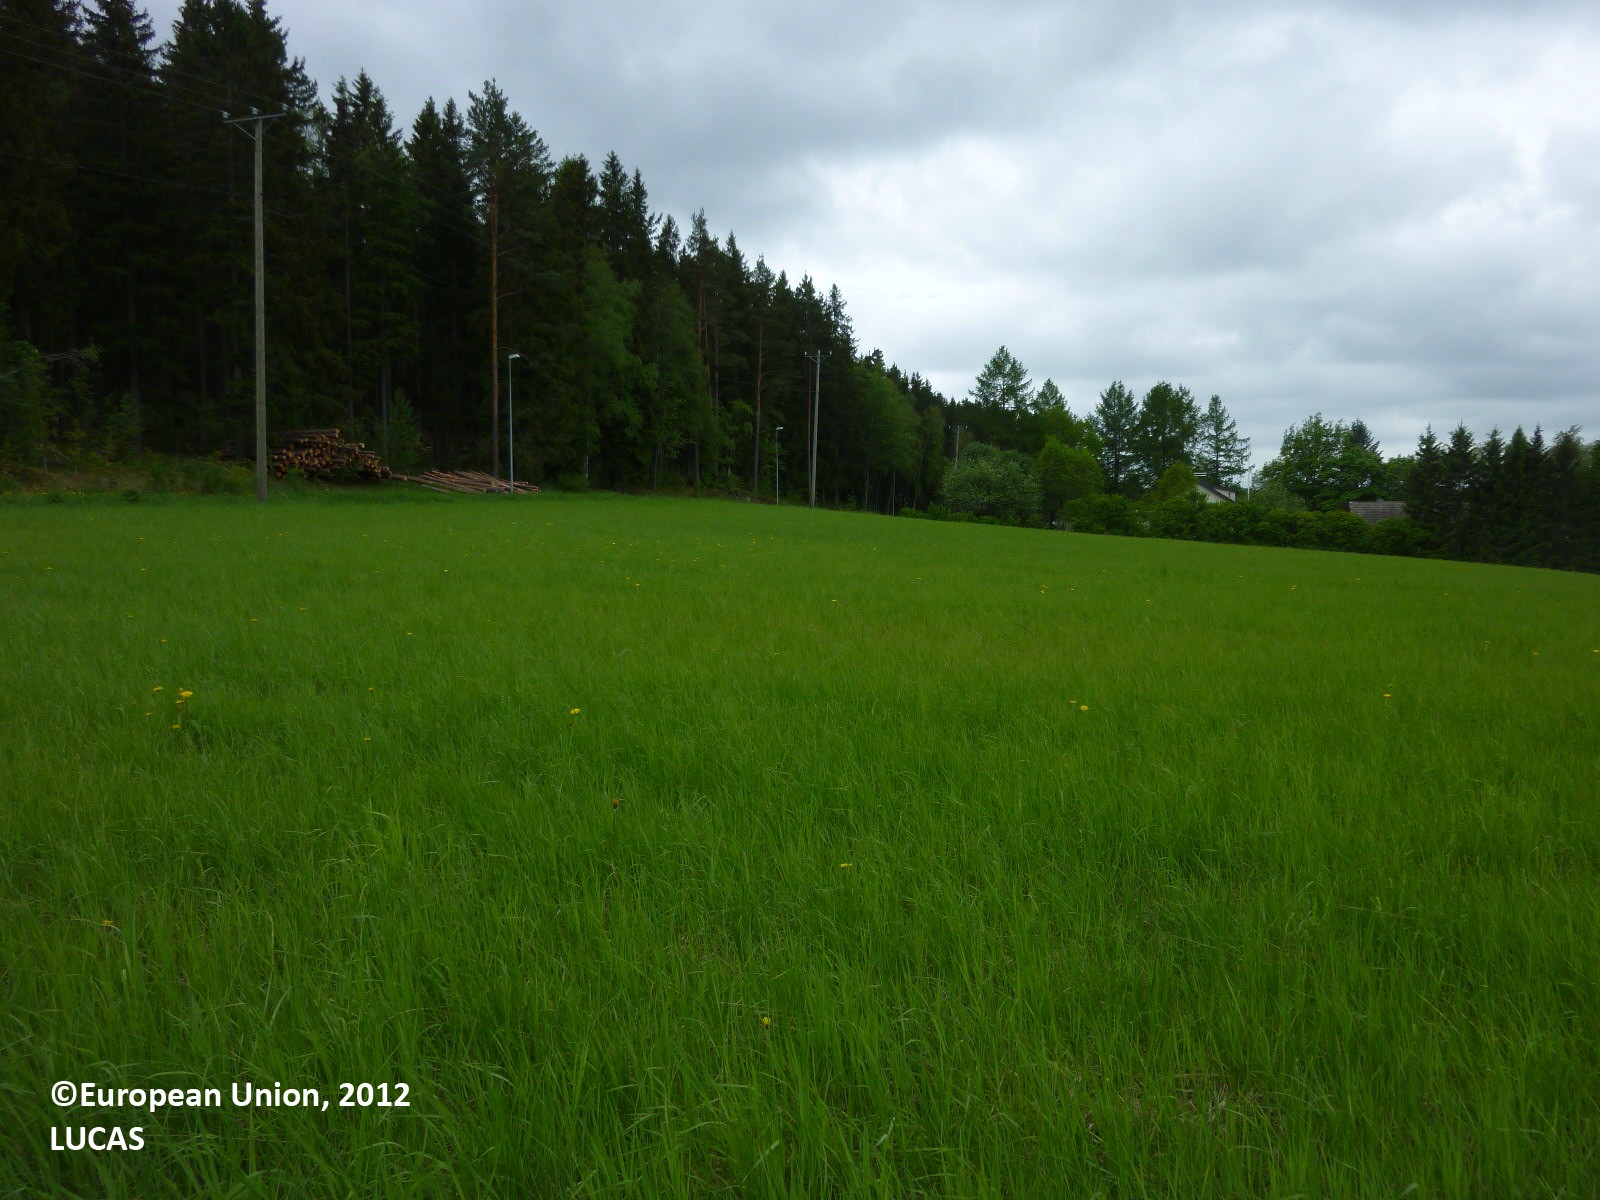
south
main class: Cropland
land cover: Temporary grasslands
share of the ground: > 75 %
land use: Agriculture (excluding fallow land and kitchen gardens)
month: June
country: FI
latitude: 60.4614
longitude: 22.7115
